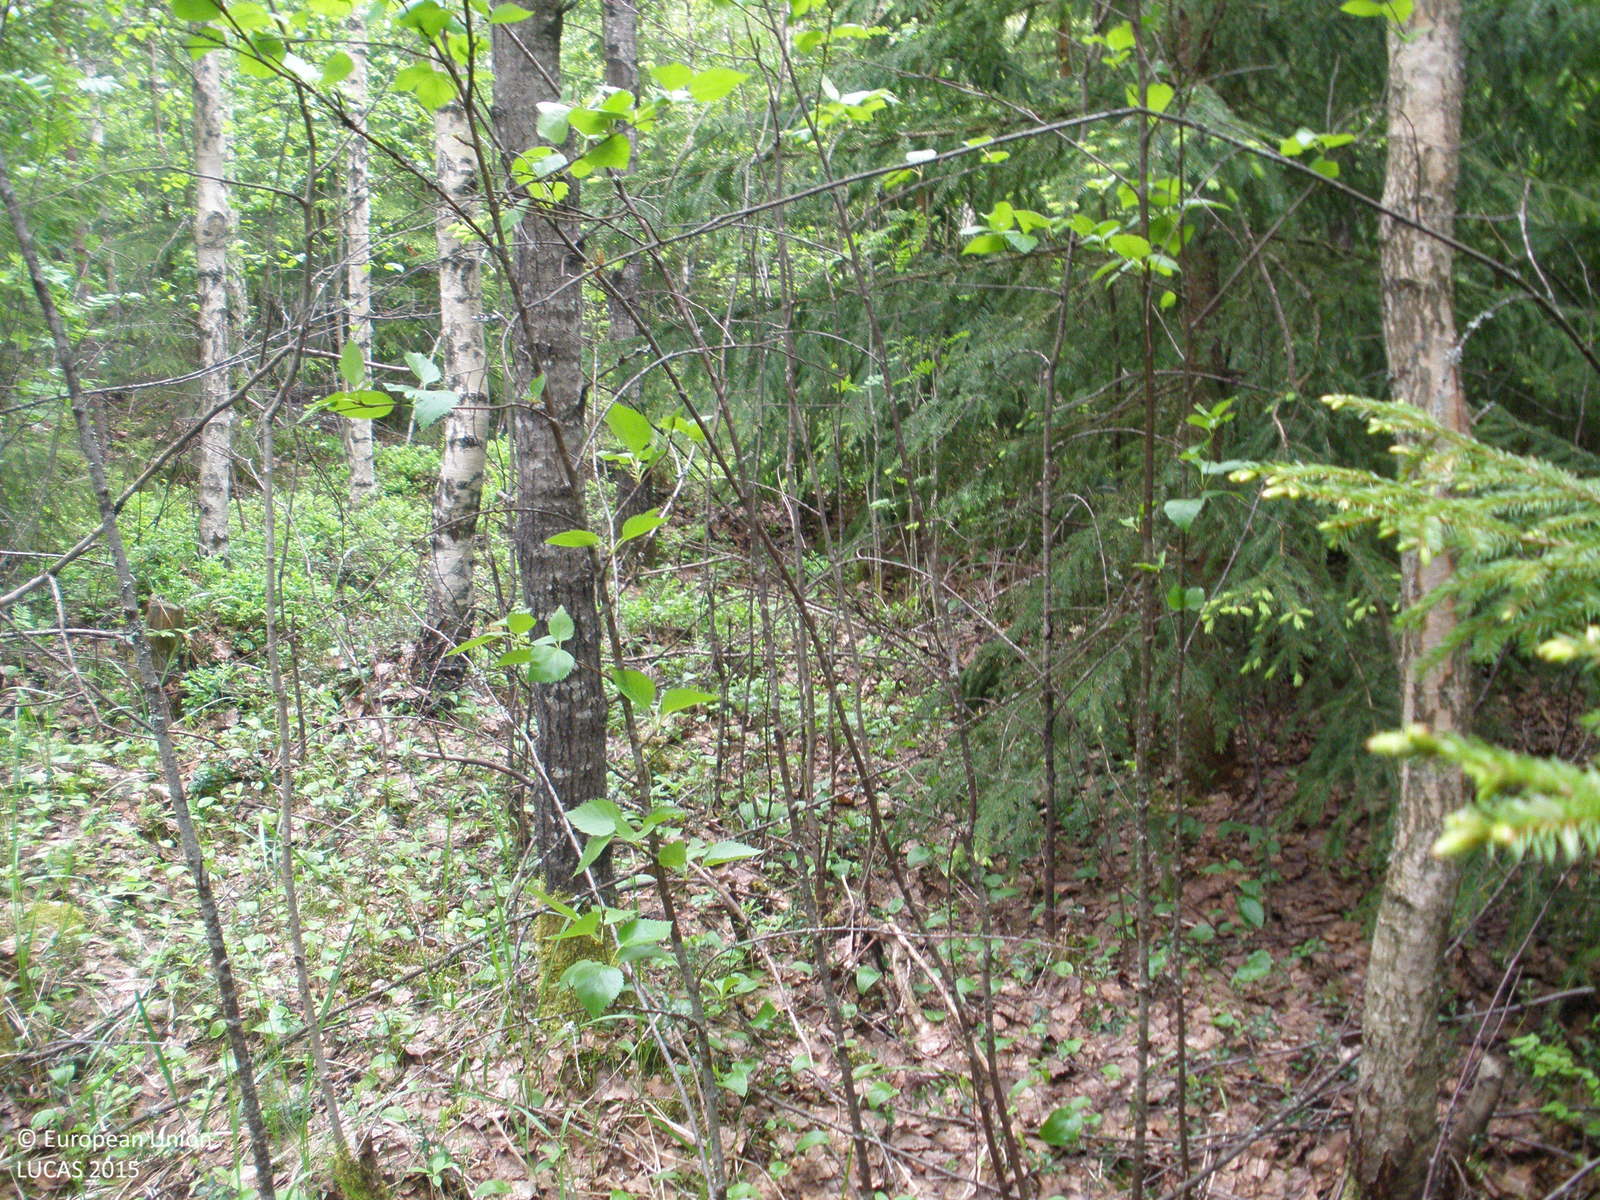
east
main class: Woodland
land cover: Other mixed woodland
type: boreal forest
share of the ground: > 75 %
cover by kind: broadleaved forest trees 70 %, coniferous forest trees 25 %, shrubs 5 %
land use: Forestry
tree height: > 5 m
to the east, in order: Other mixed woodland; Ditches and canals; Other mixed woodland; Pine dominated mixed woodland; Spruce dominated coniferous woodland
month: June
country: FI
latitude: 60.5909
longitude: 23.0960
